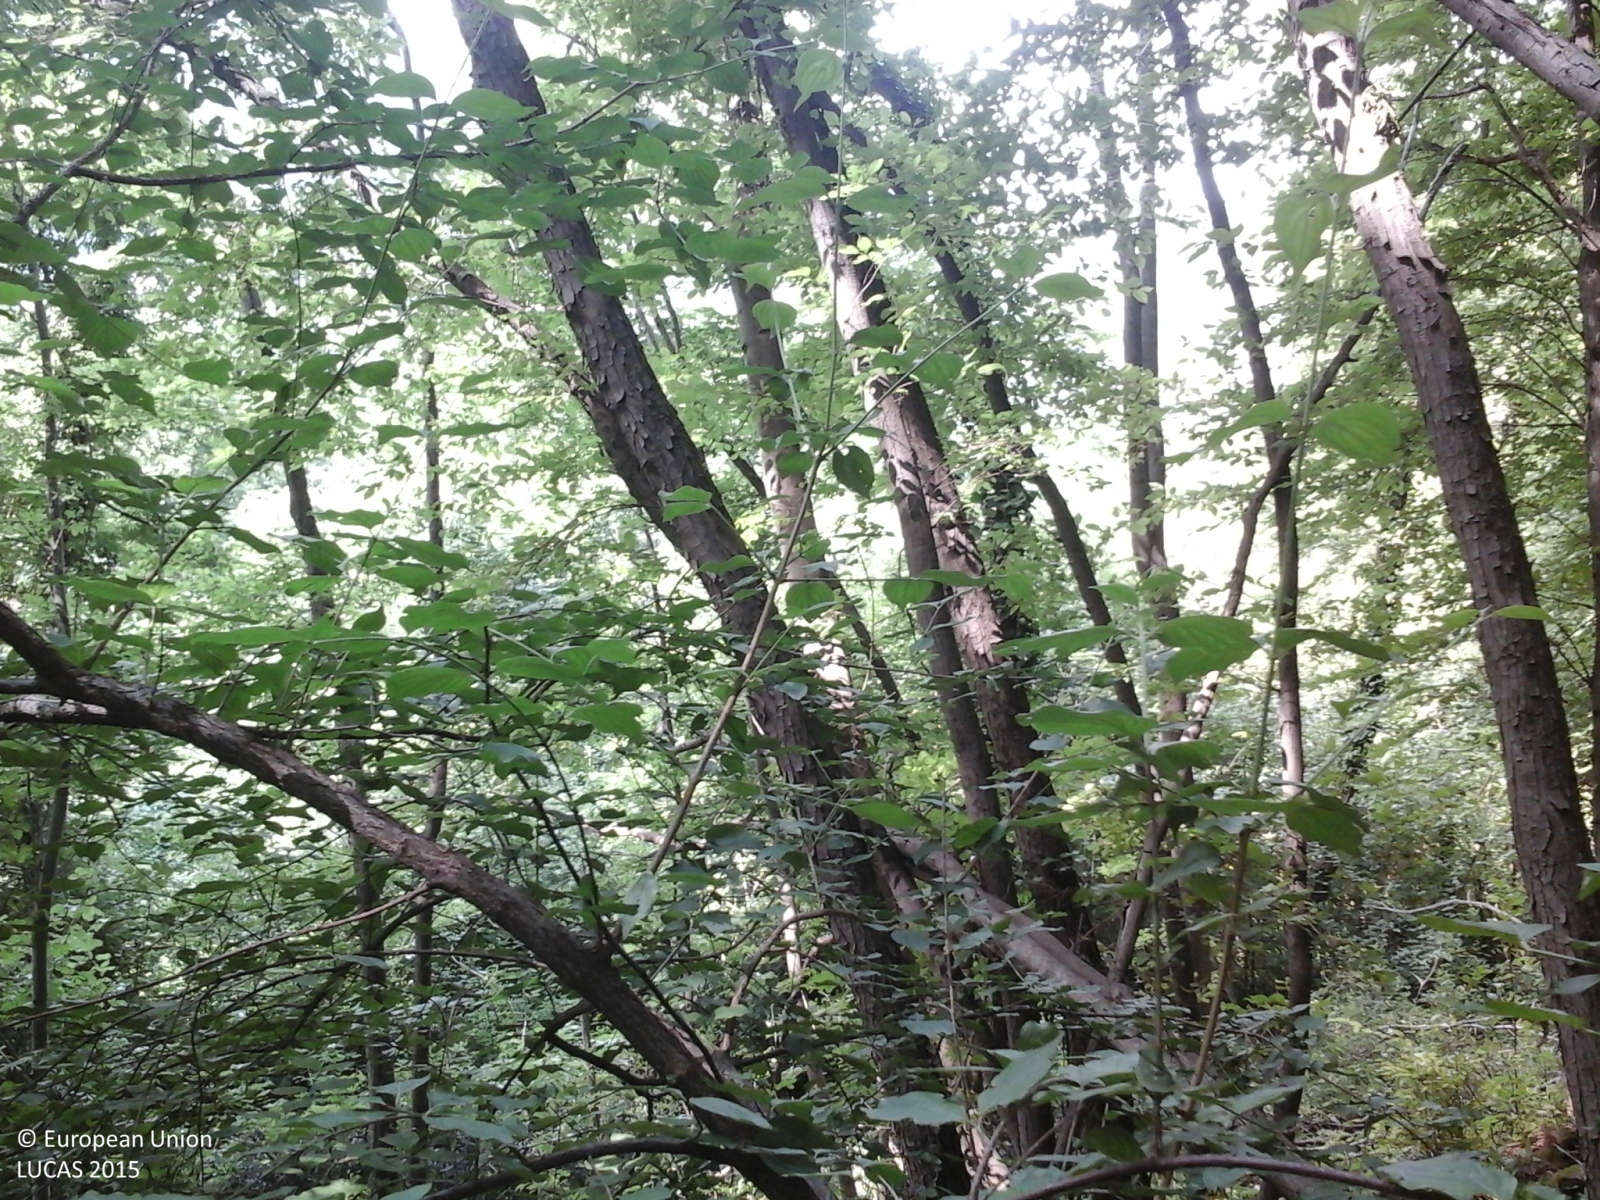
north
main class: Woodland
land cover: Broadleaved woodland
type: thermophilous deciduous forest
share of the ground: > 75 %
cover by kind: broadleaved forest trees 100 %
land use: Semi-natural and natural areas not in use
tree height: > 5 m
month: June
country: IT
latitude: 45.2925
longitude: 11.6929
